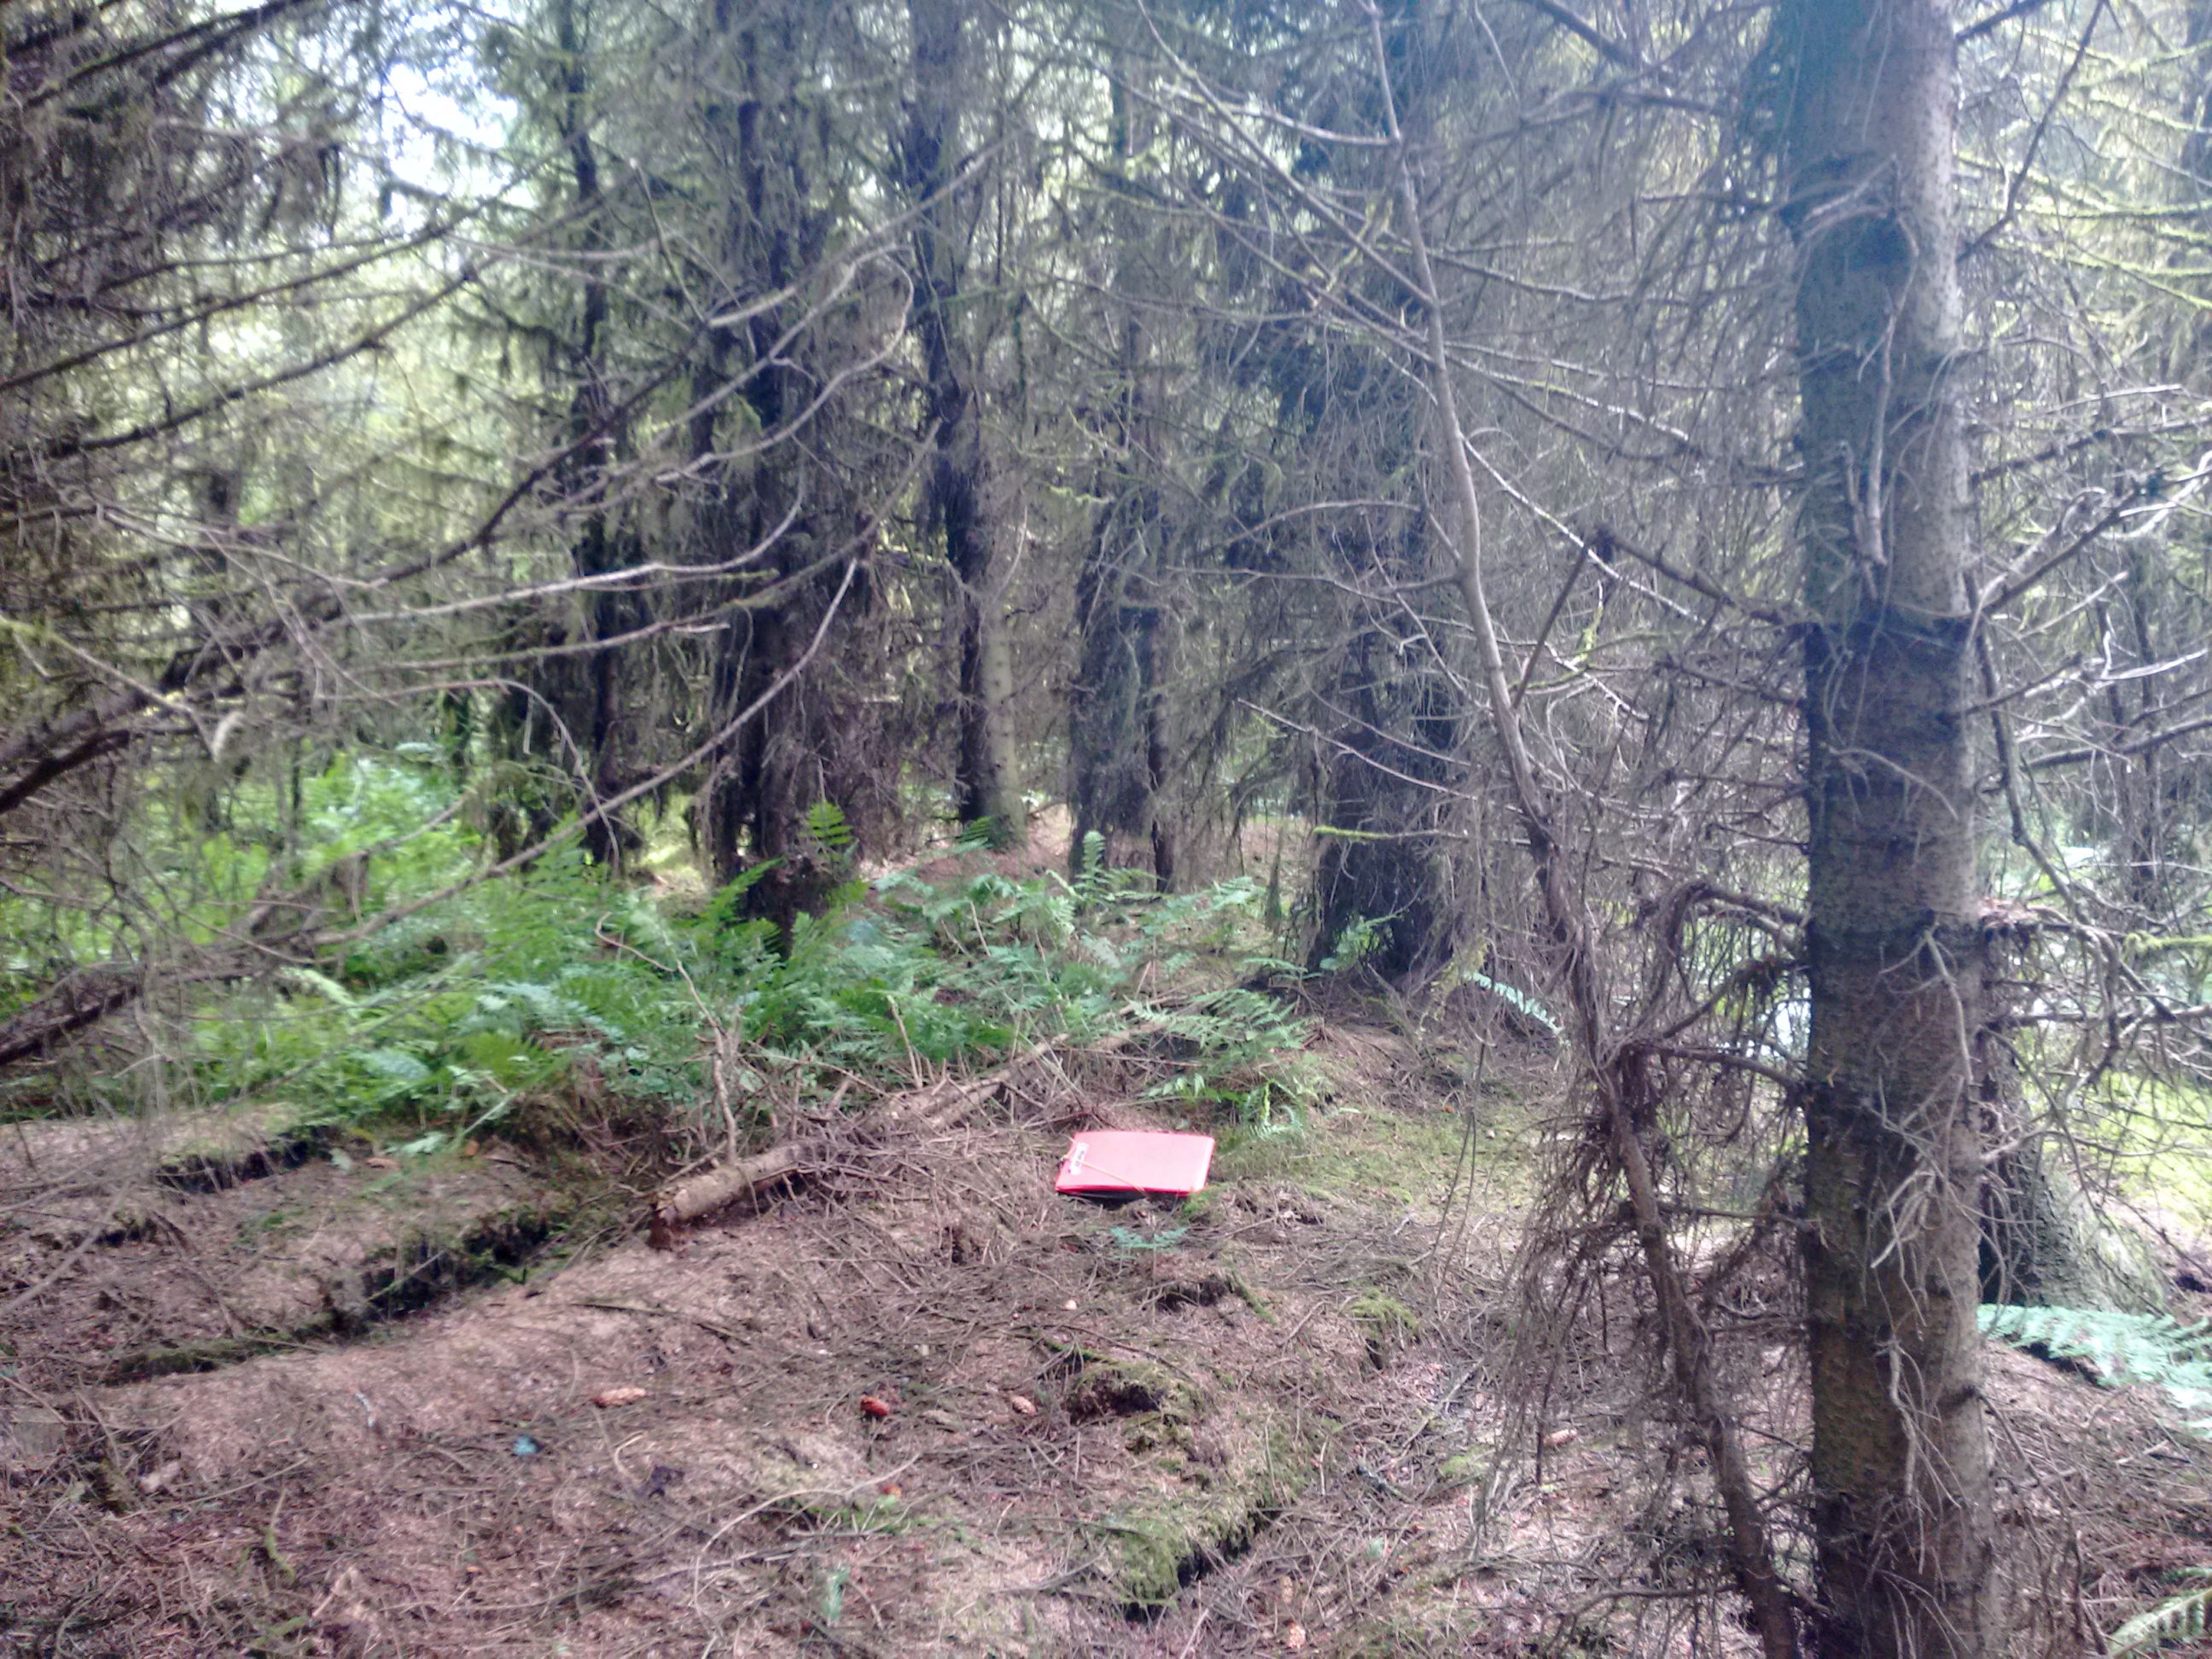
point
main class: Woodland
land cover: Spruce dominated coniferous woodland
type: exotic forest
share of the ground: > 75 %
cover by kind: coniferous forest trees 100 %
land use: Forestry
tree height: > 5 m
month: July
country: GB
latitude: 54.5905
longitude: -7.0559
